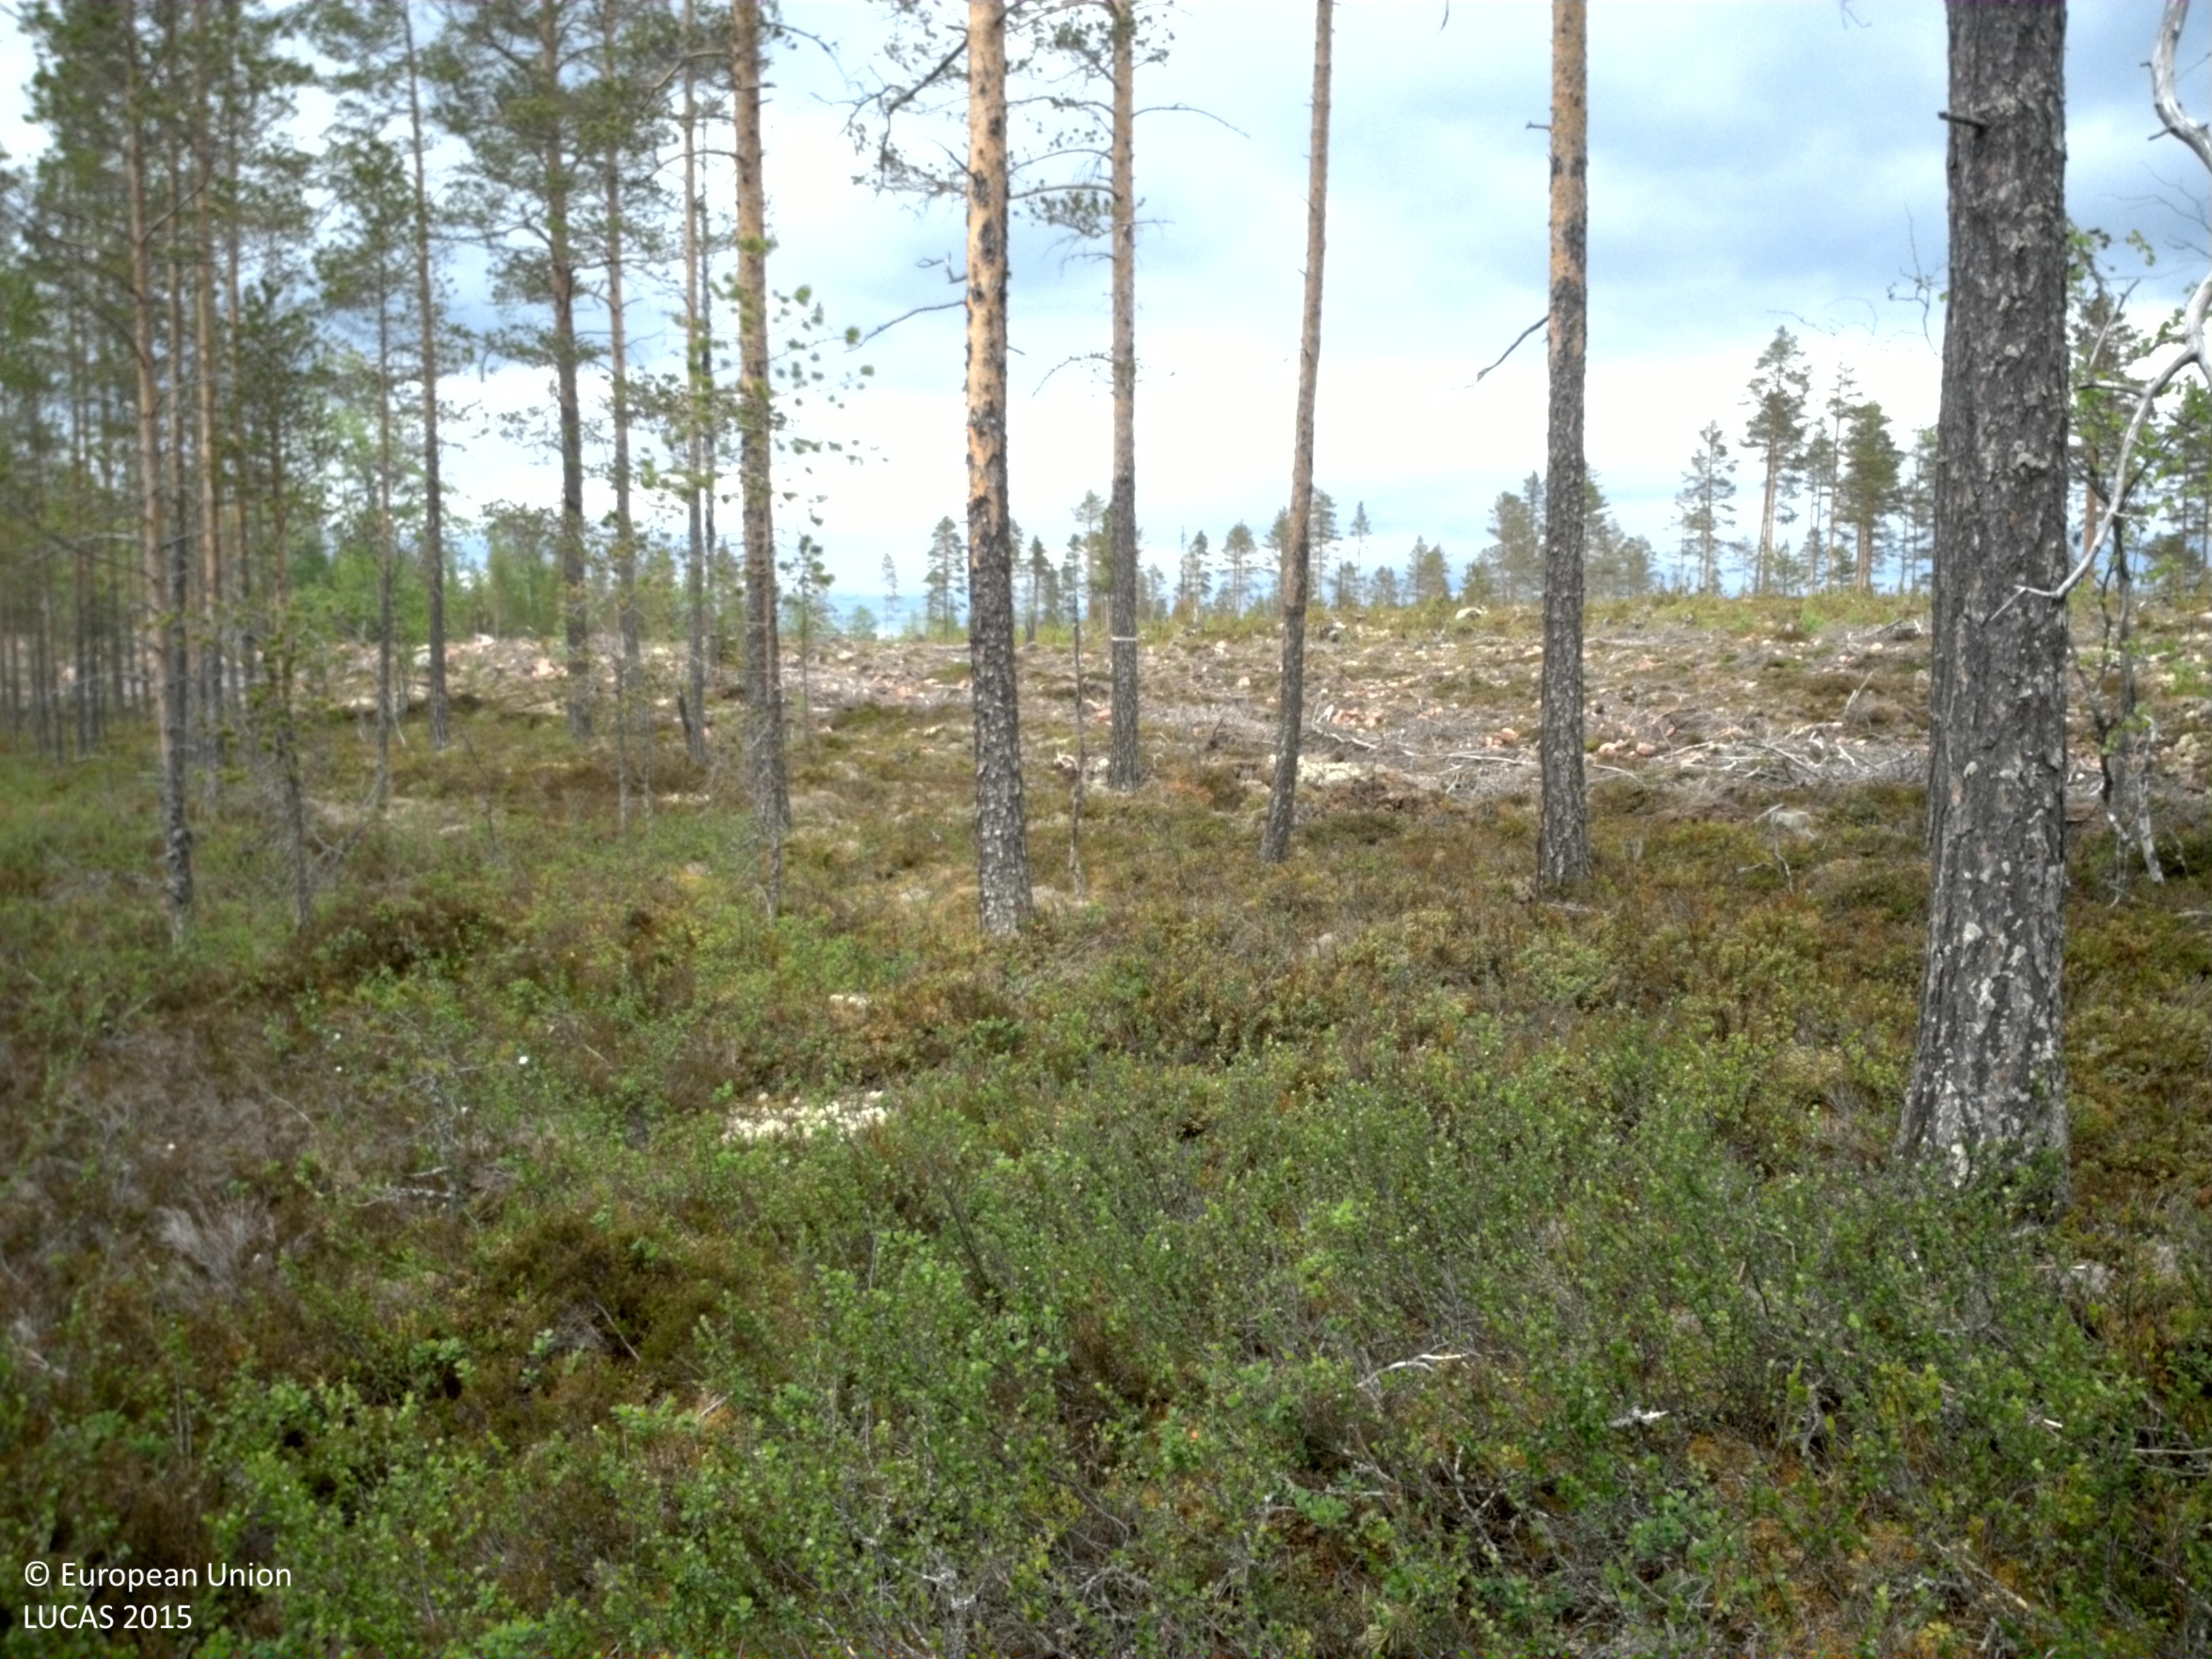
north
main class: Woodland
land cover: Pine dominated coniferous woodland
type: boreal forest
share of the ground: 50 - 75 %
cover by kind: coniferous forest trees 60 %, herbaceous plants 20 %, lichens and mosses 20 %
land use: Forestry
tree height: > 5 m
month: June
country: SE
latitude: 61.3067
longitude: 13.5911
